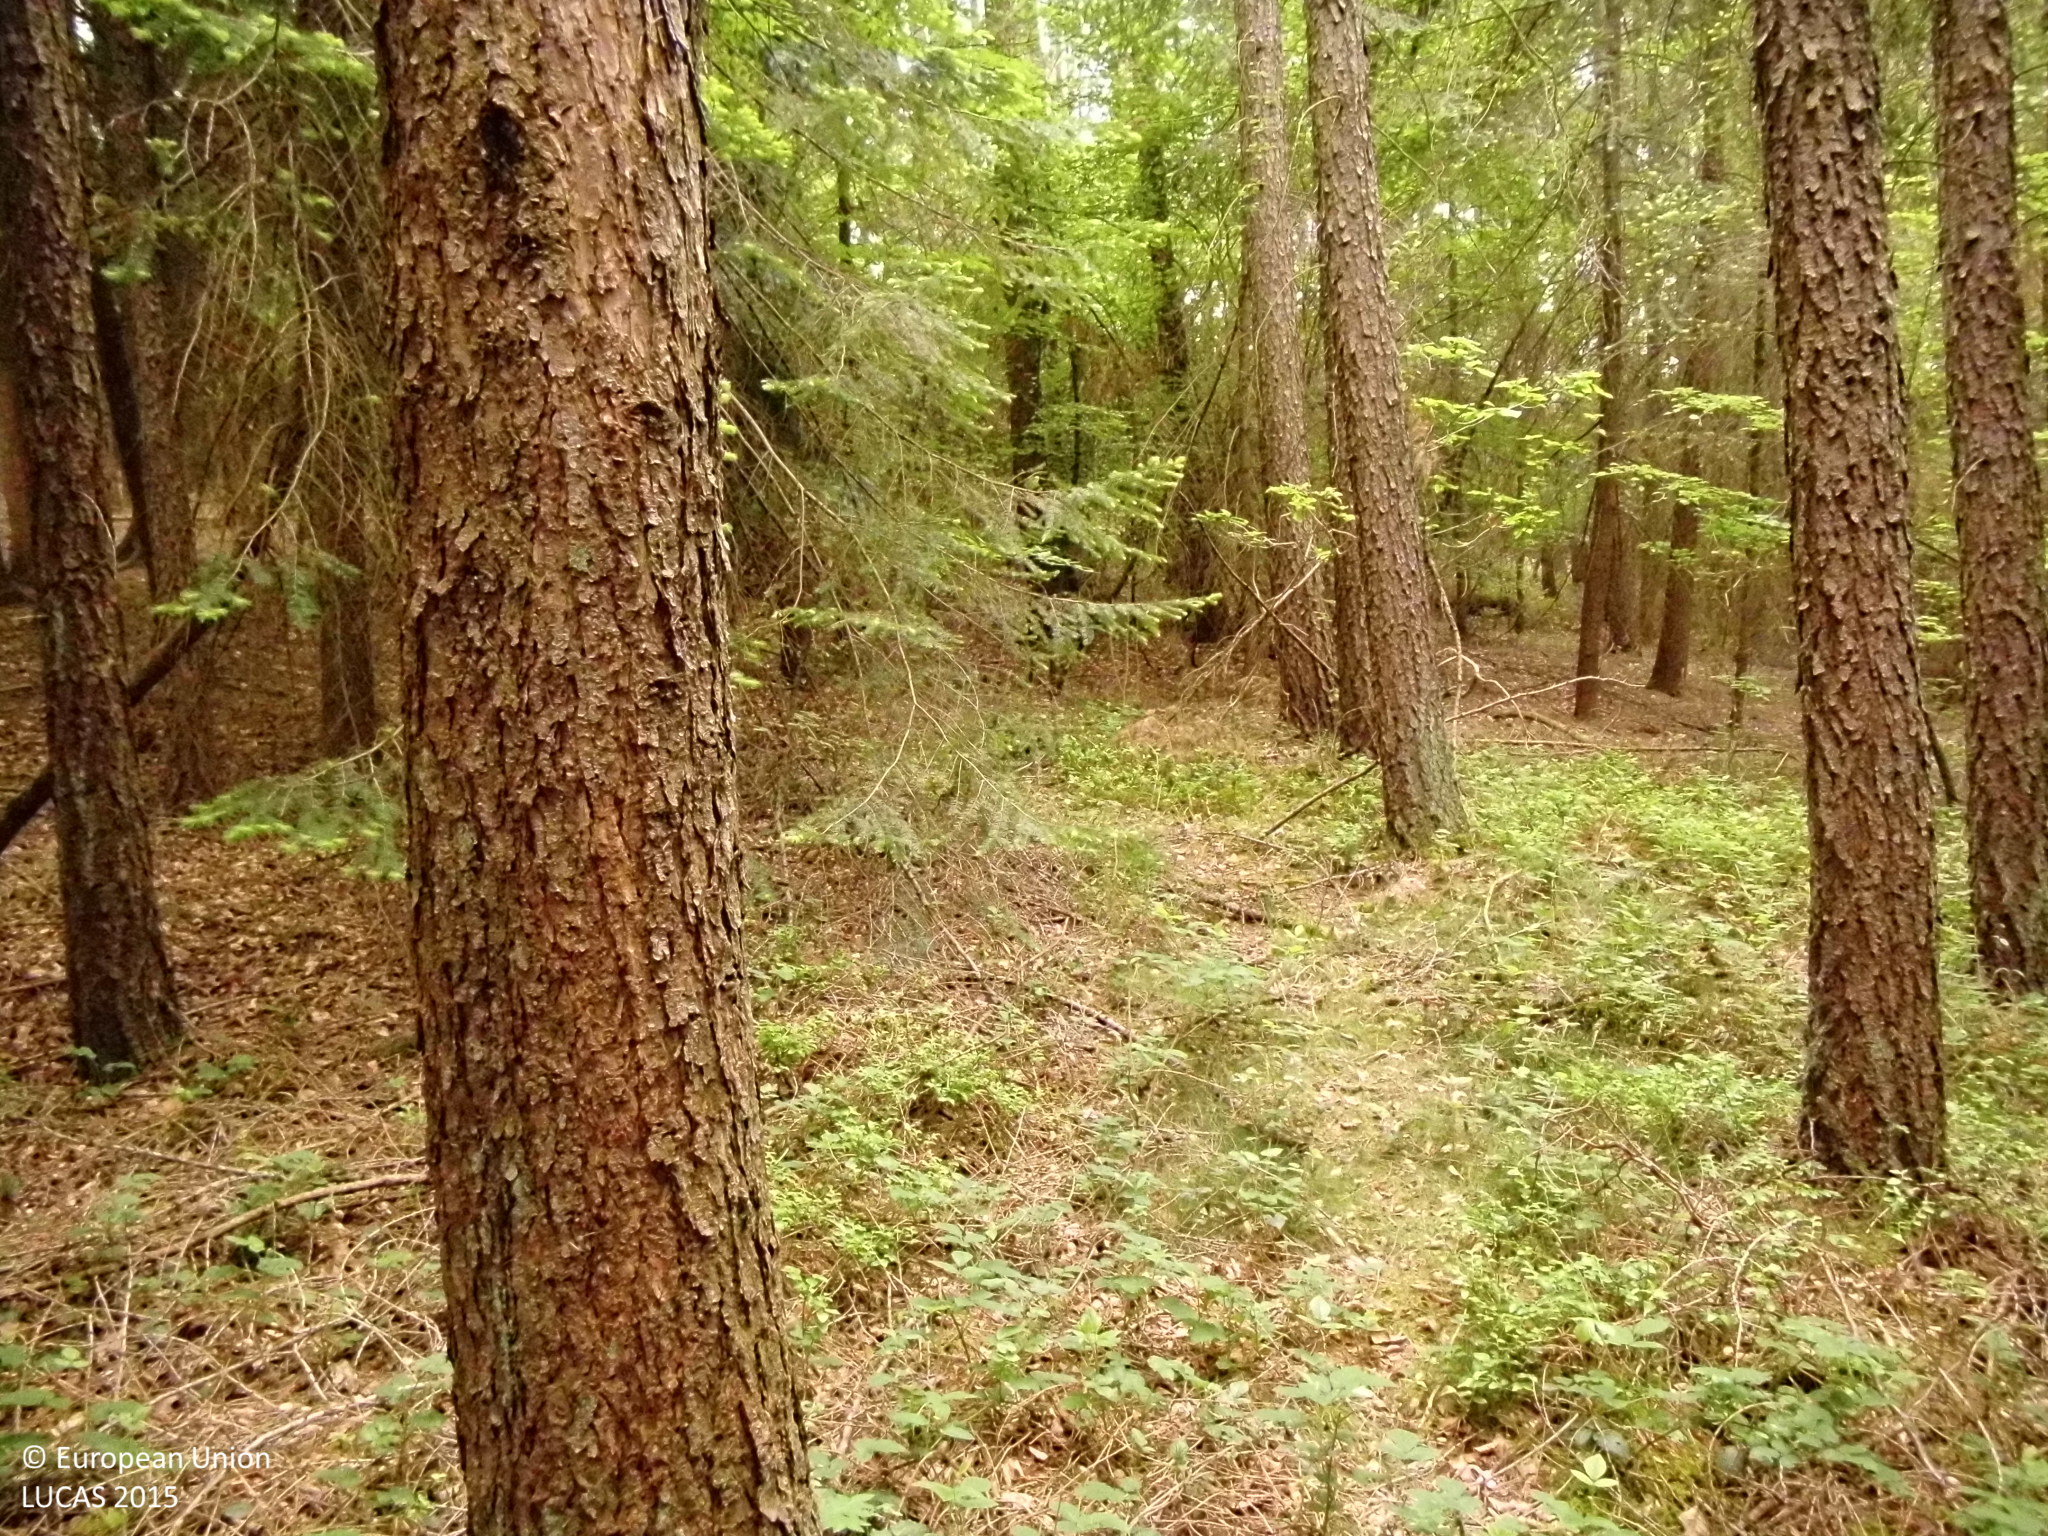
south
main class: Woodland
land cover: Other mixed woodland
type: hemiboreal forest and nemoral coniferous forest and mixed broadleaved-coniferous forest
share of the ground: > 75 %
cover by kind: coniferous forest trees 60 %, broadleaved forest trees 25 %, herbaceous plants 10 %, lichens and mosses 5 %
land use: Forestry
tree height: > 5 m
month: May
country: DE
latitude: 50.7503
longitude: 7.4915
